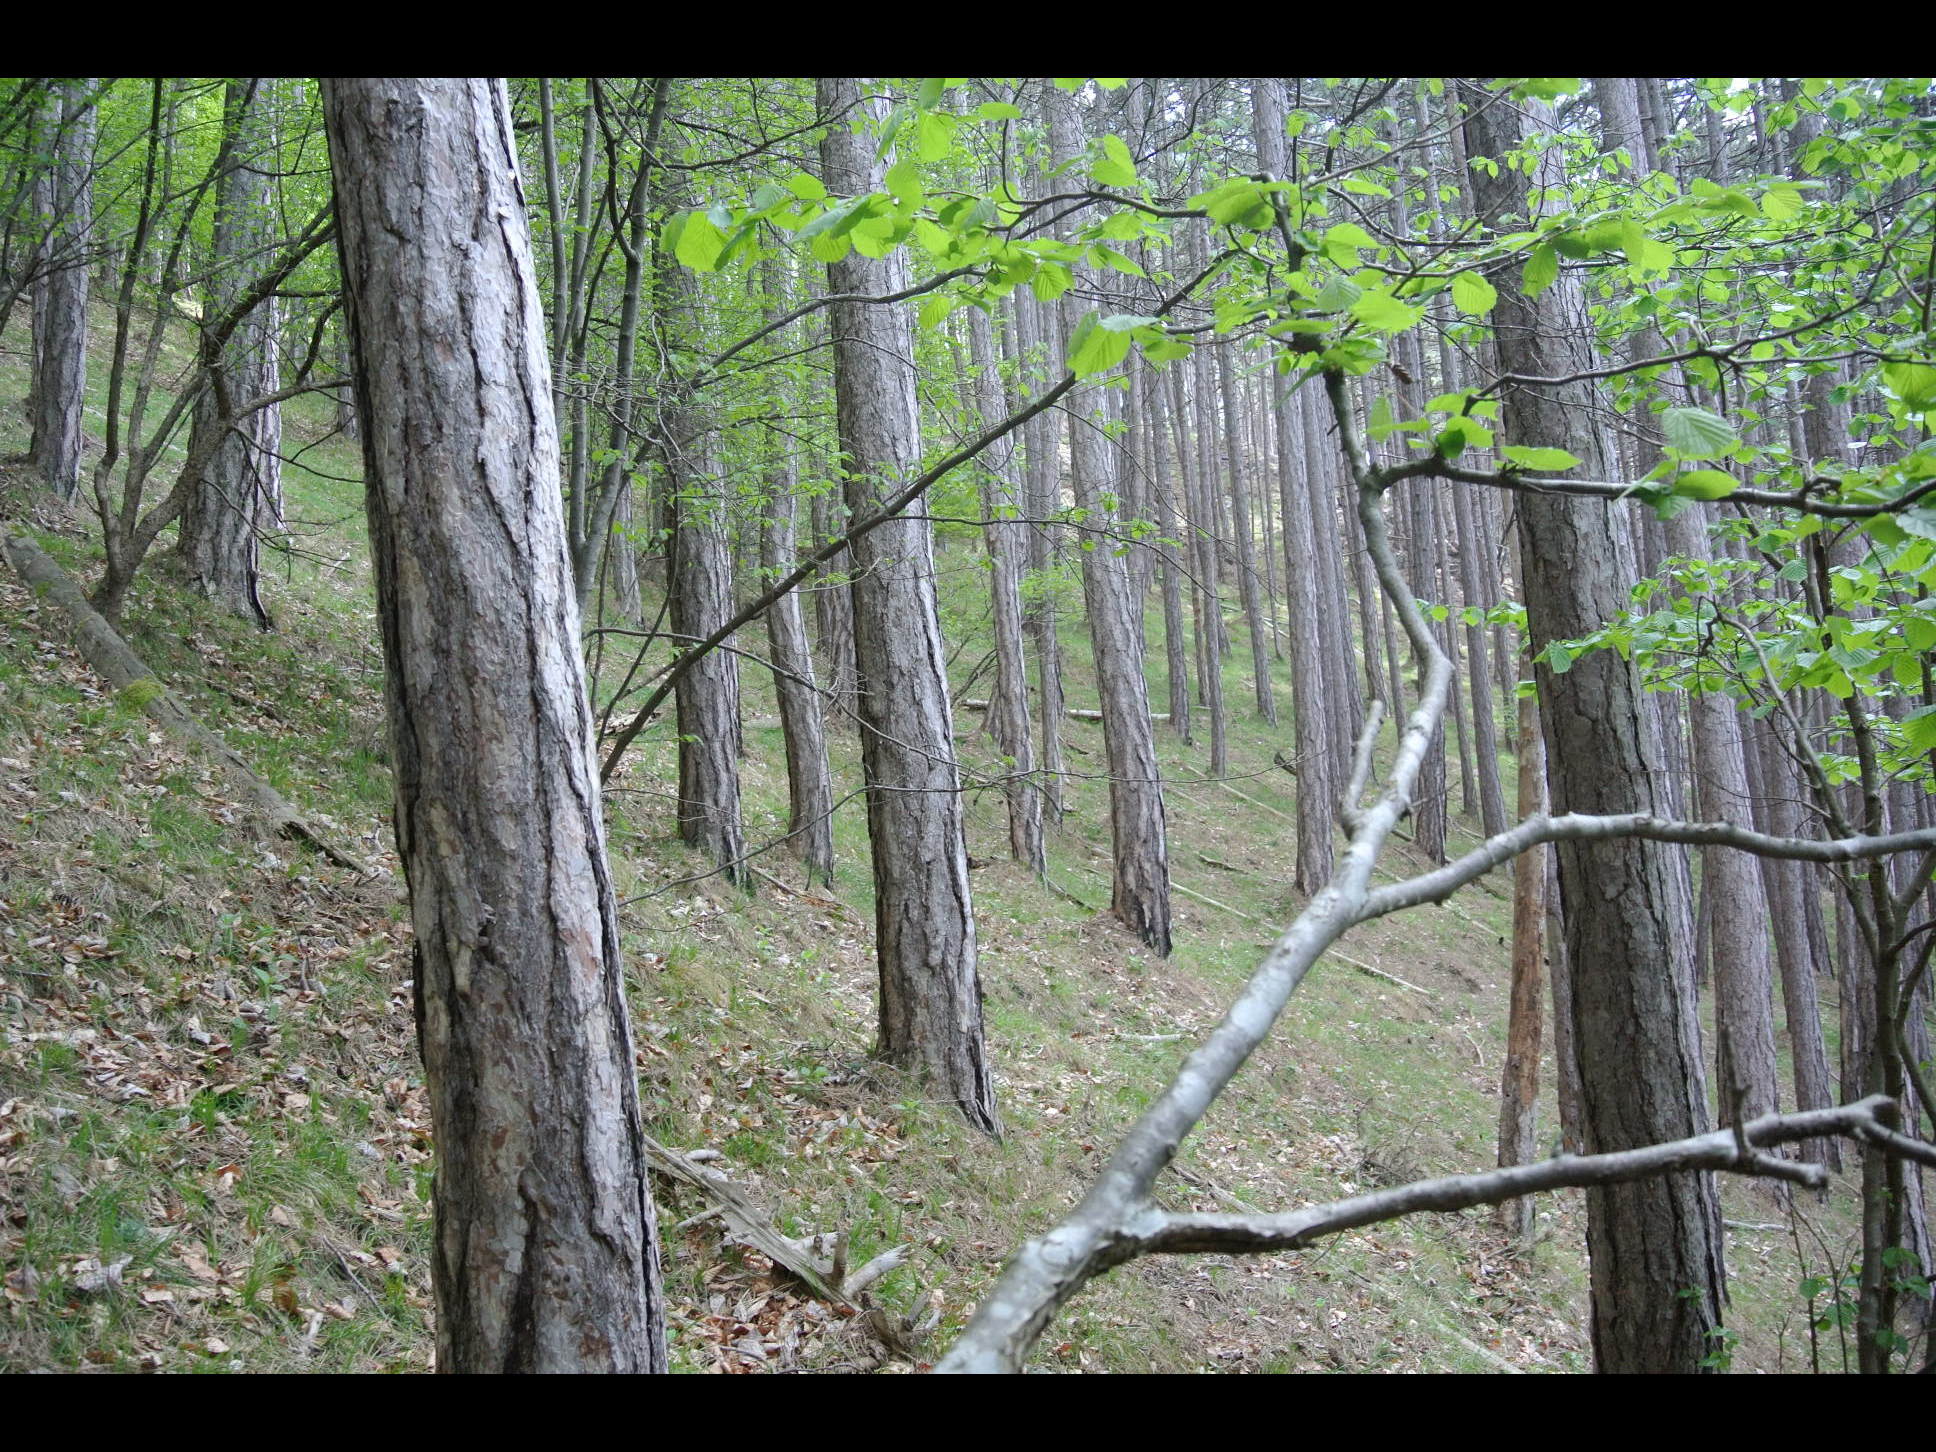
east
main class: Woodland
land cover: Pine dominated coniferous woodland
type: alpine coniferous forest
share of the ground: > 75 %
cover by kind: coniferous forest trees 95 %, broadleaved forest trees 5 %
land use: Forestry
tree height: > 5 m
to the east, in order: Pine dominated coniferous woodland; Pine dominated mixed woodland; Ditches and canals; Pine dominated mixed woodland
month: May
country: AT
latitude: 47.8778
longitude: 16.0336
